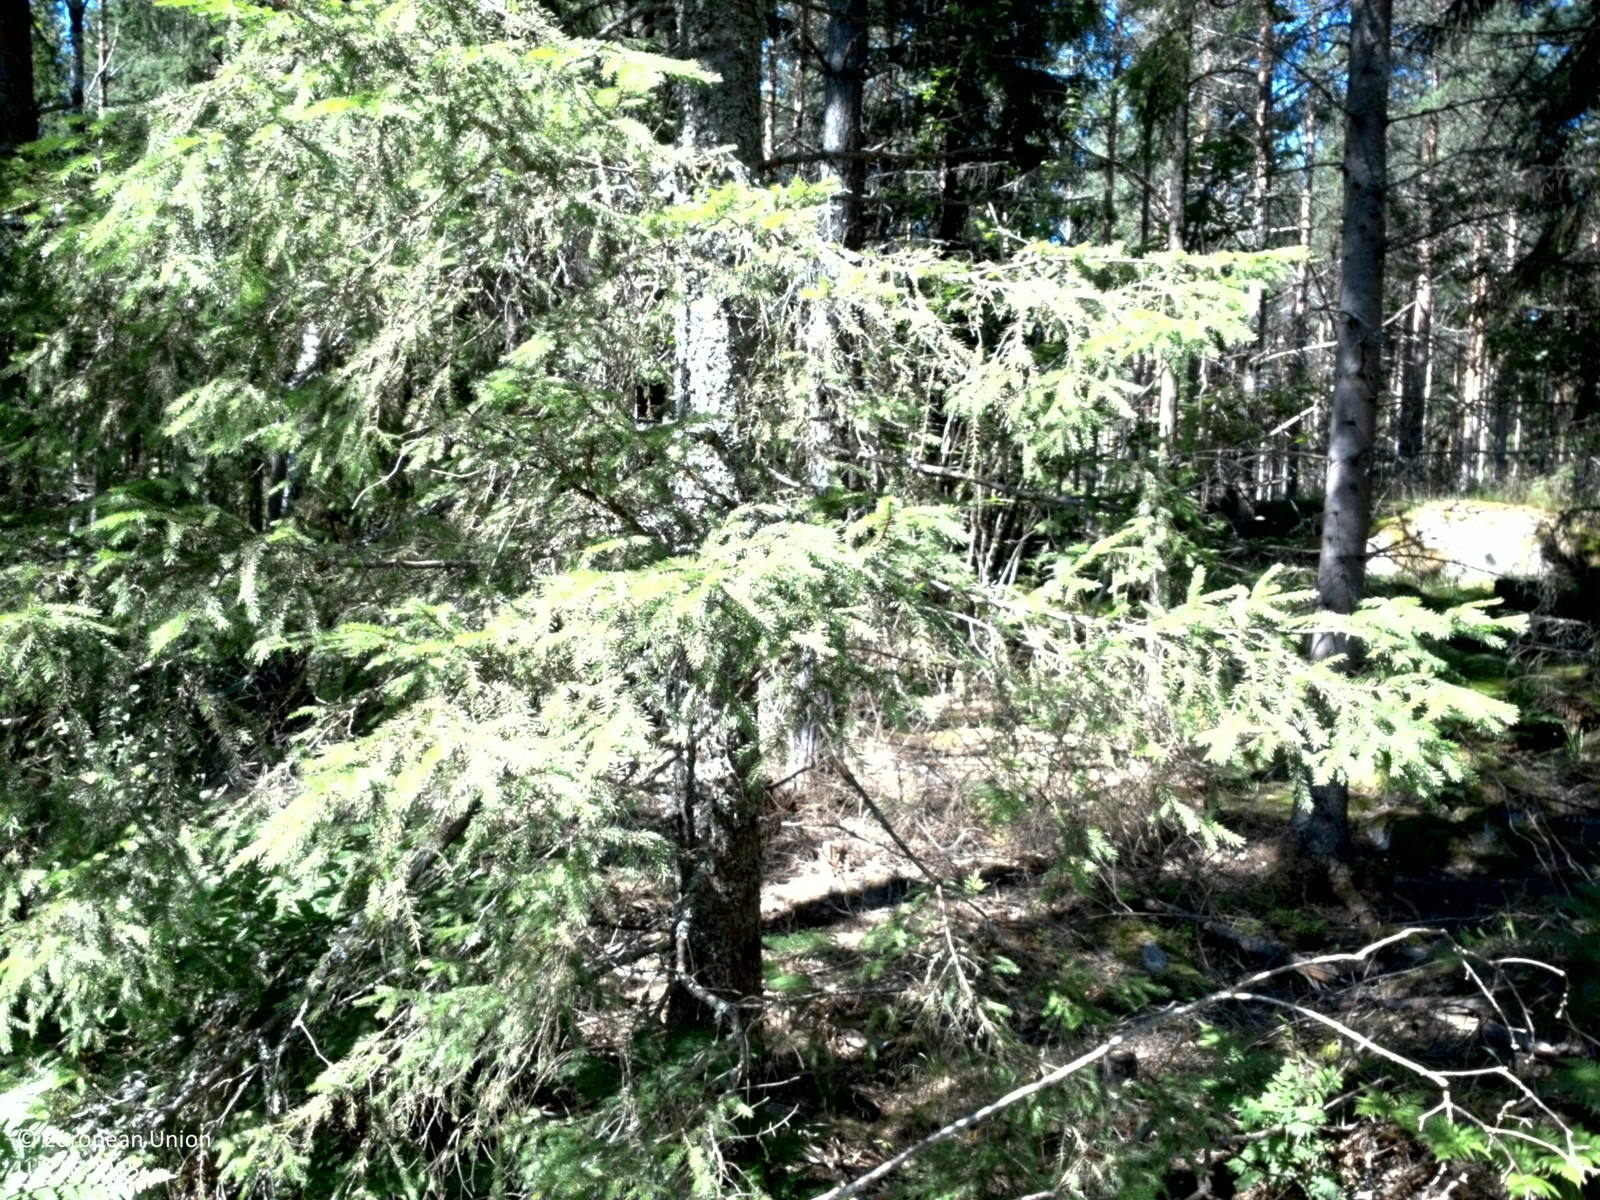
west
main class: Woodland
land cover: Spruce dominated mixed woodland
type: boreal forest
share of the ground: 25 - 50 %
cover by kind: herbaceous plants 40 %, coniferous forest trees 30 %, broadleaved forest trees 20 %, consolidated bare surface 10 %
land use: Forestry
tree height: > 5 m
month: August
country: SE
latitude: 59.5537
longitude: 18.3321
